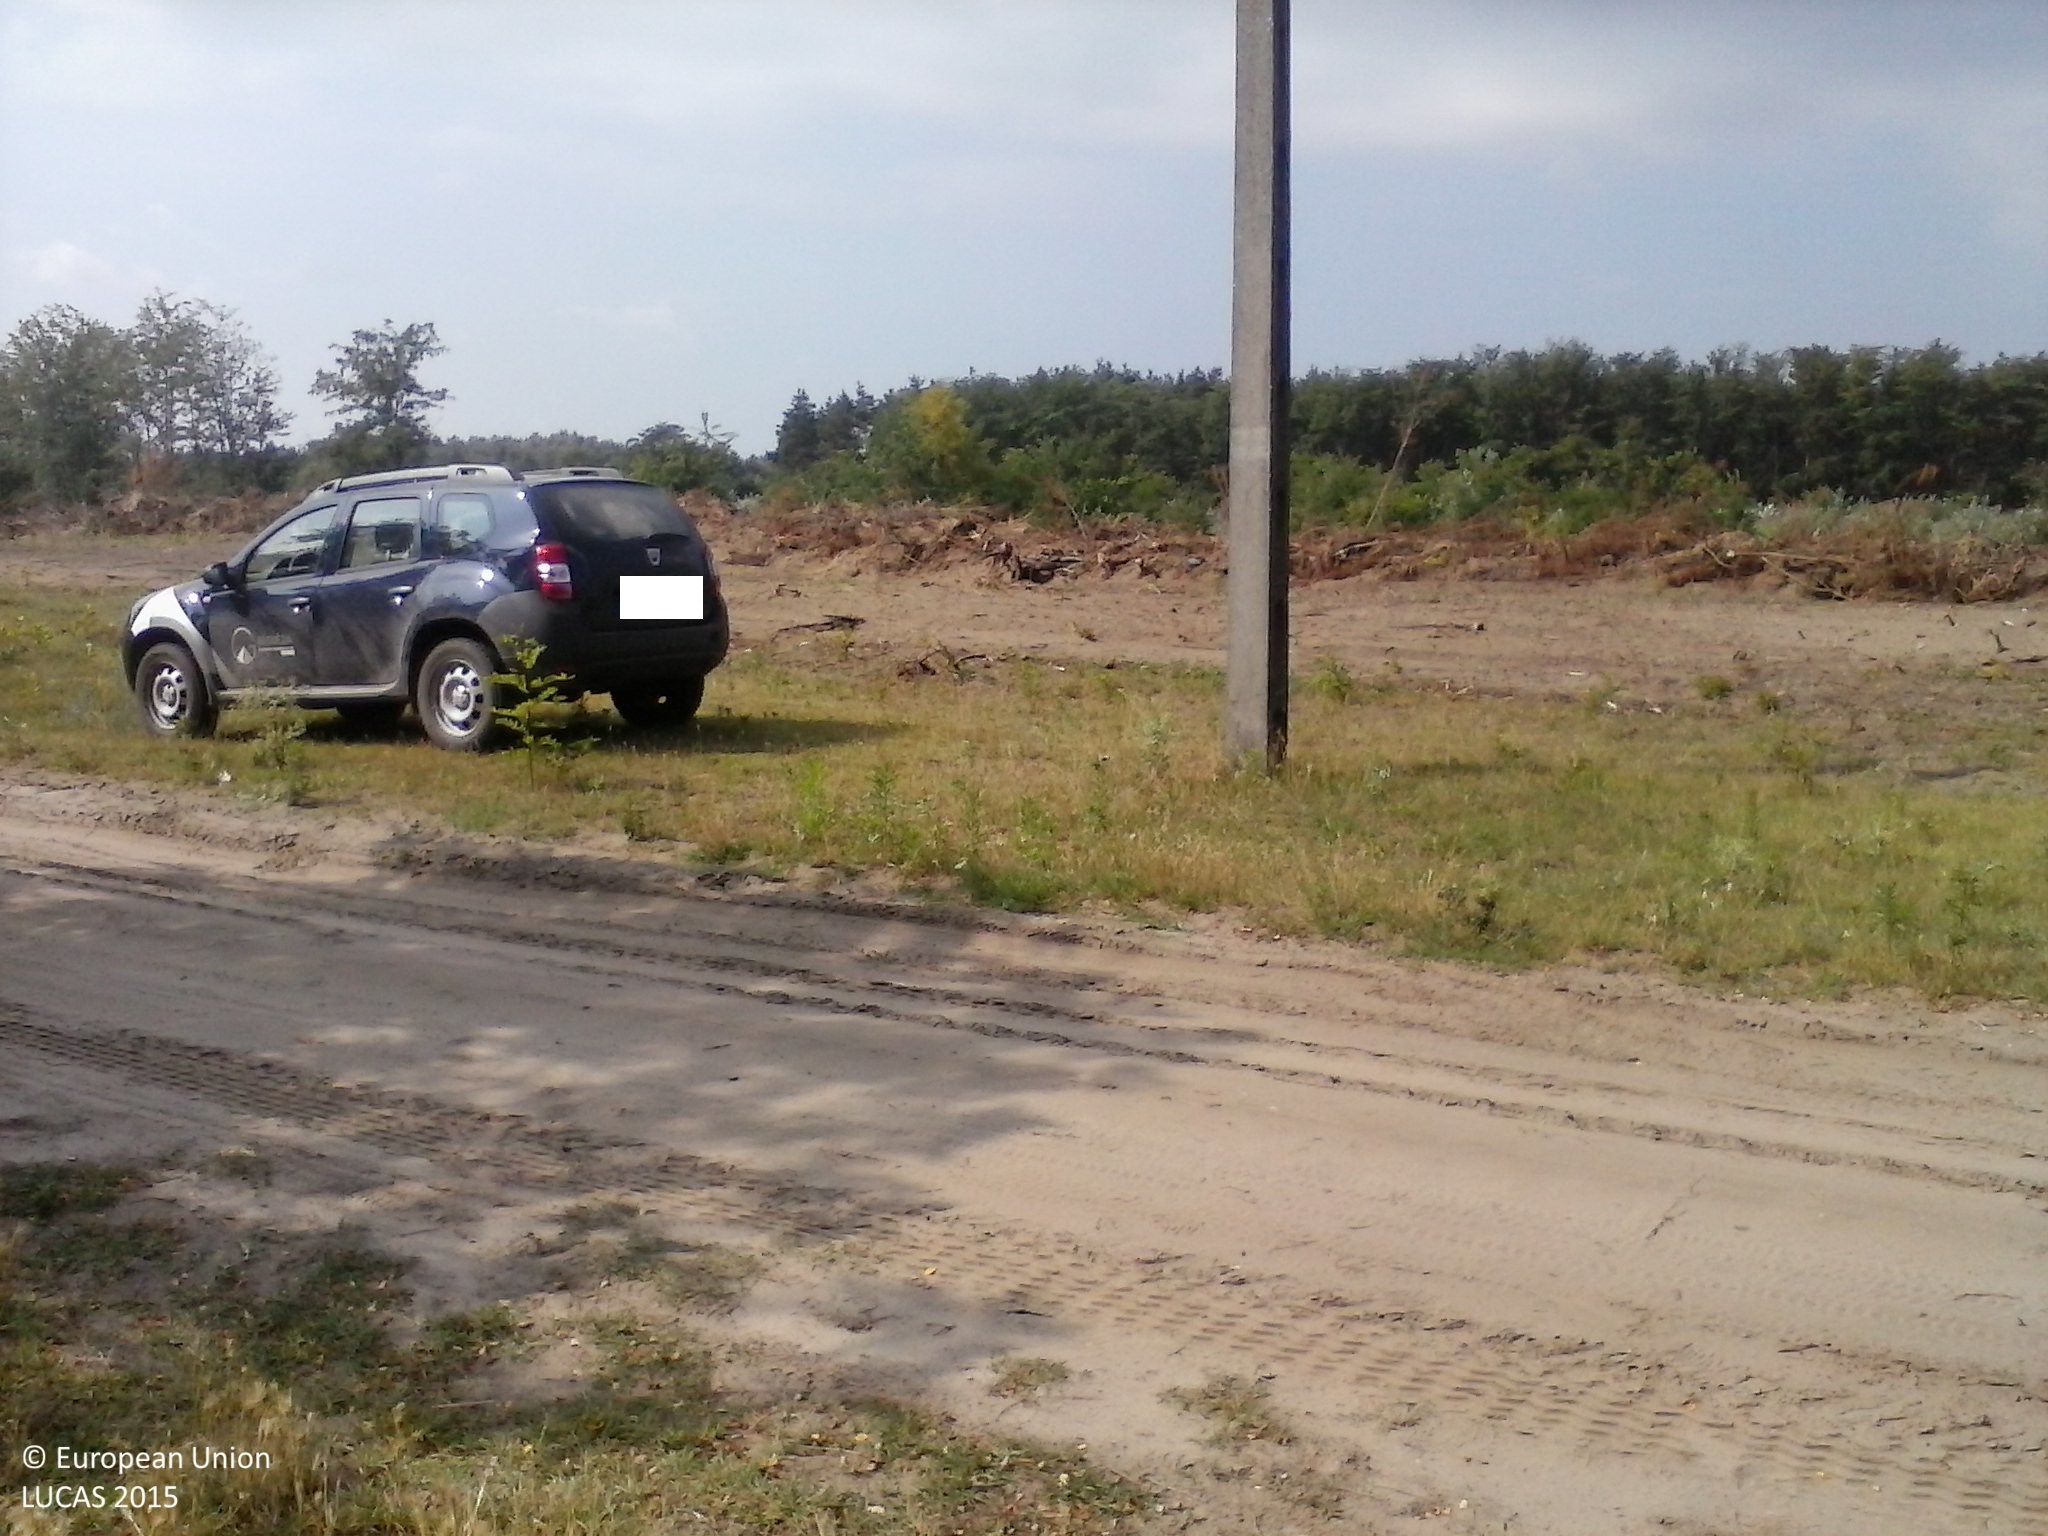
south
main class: Artificial land
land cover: Non built-up area features
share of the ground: > 75 %
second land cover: Spontaneously vegetated surfaces
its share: > 75 %
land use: Residential
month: June
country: HU
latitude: 46.2401
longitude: 19.6532
